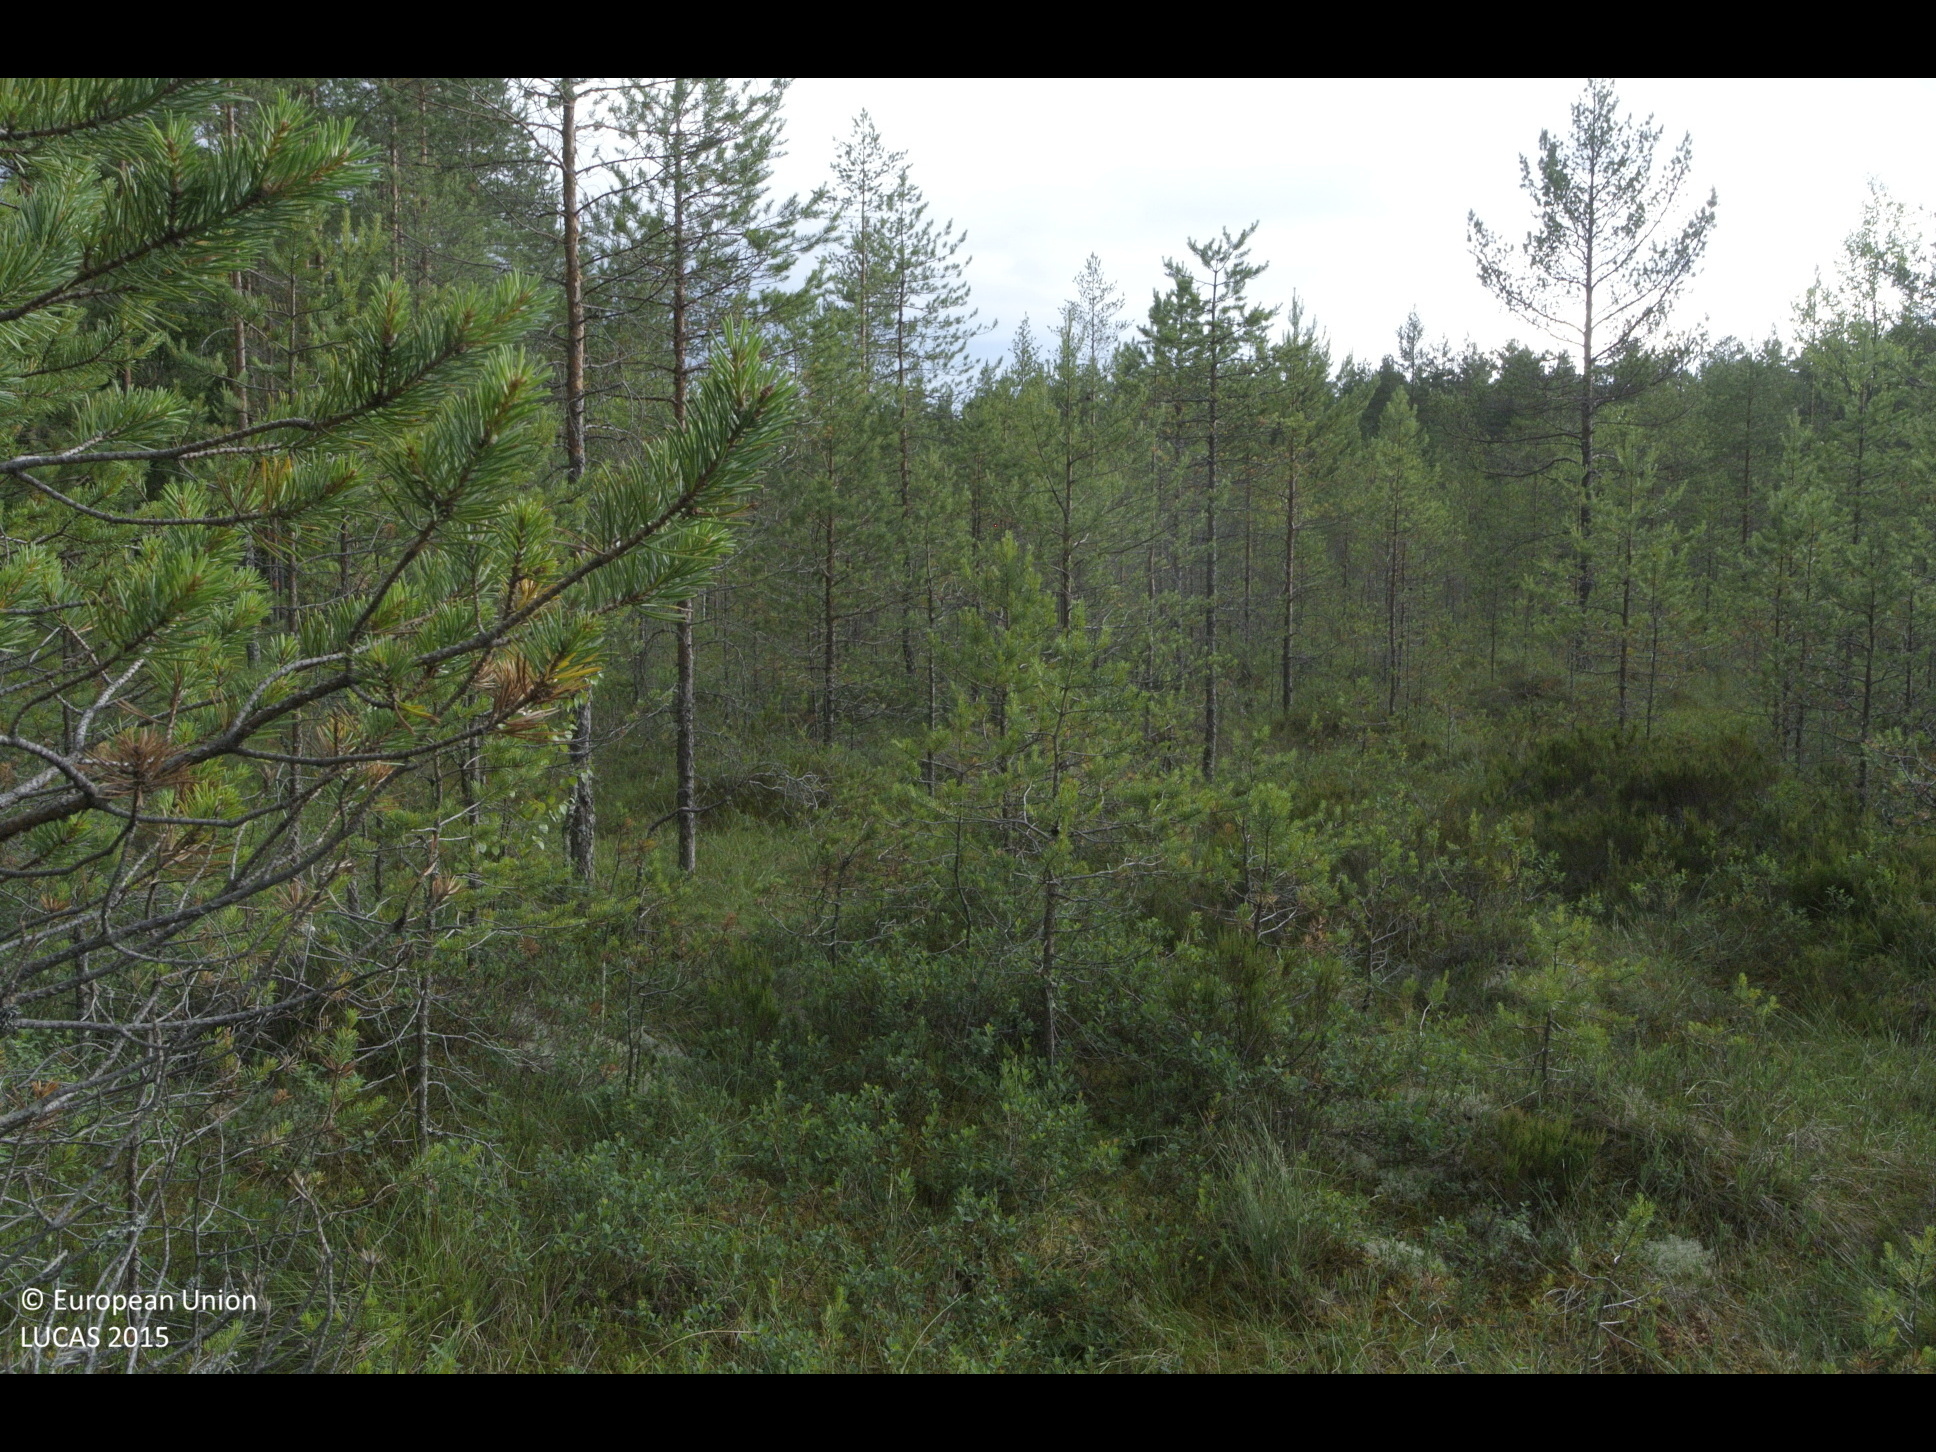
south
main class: Woodland
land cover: Pine dominated coniferous woodland
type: boreal forest
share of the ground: 10 - 25 %
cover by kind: shrubs 40 %, herbaceous plants 30 %, coniferous forest trees 15 %, lichens and mosses 15 %
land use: Forestry
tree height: < 5 m
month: July
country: FI
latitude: 61.3520
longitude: 25.7413
